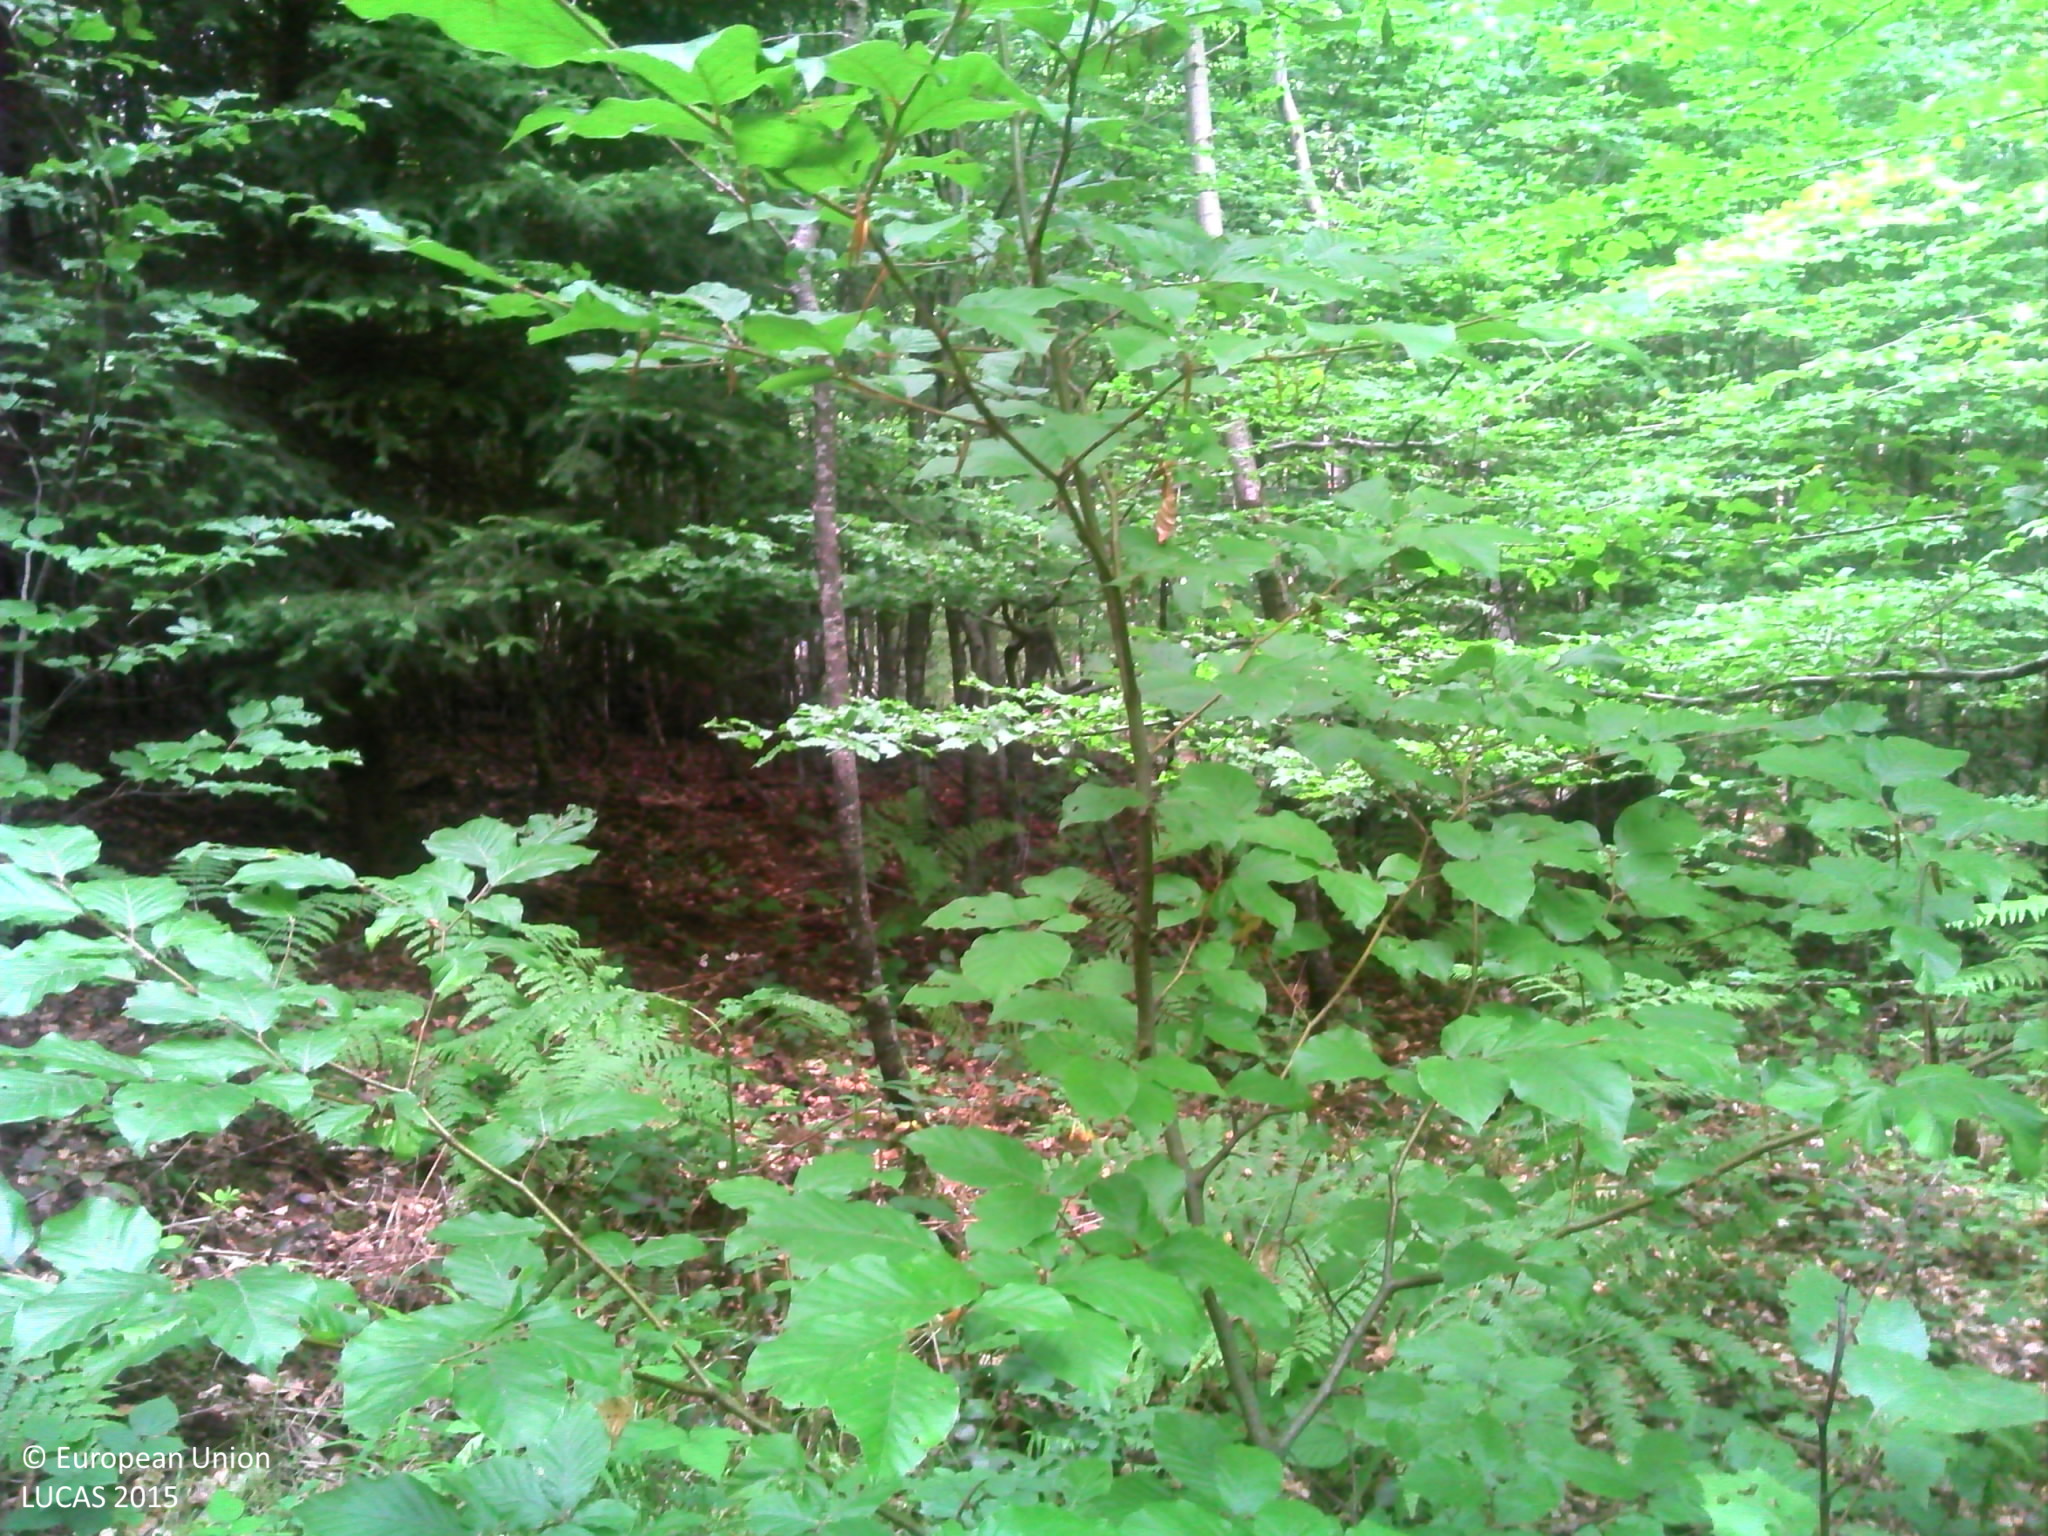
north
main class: Woodland
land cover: Broadleaved woodland
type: beech forest
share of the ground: > 75 %
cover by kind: broadleaved forest trees 90 %, herbaceous plants 10 %
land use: Forestry
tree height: > 5 m
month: June
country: FR
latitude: 47.8390
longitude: 6.3535
